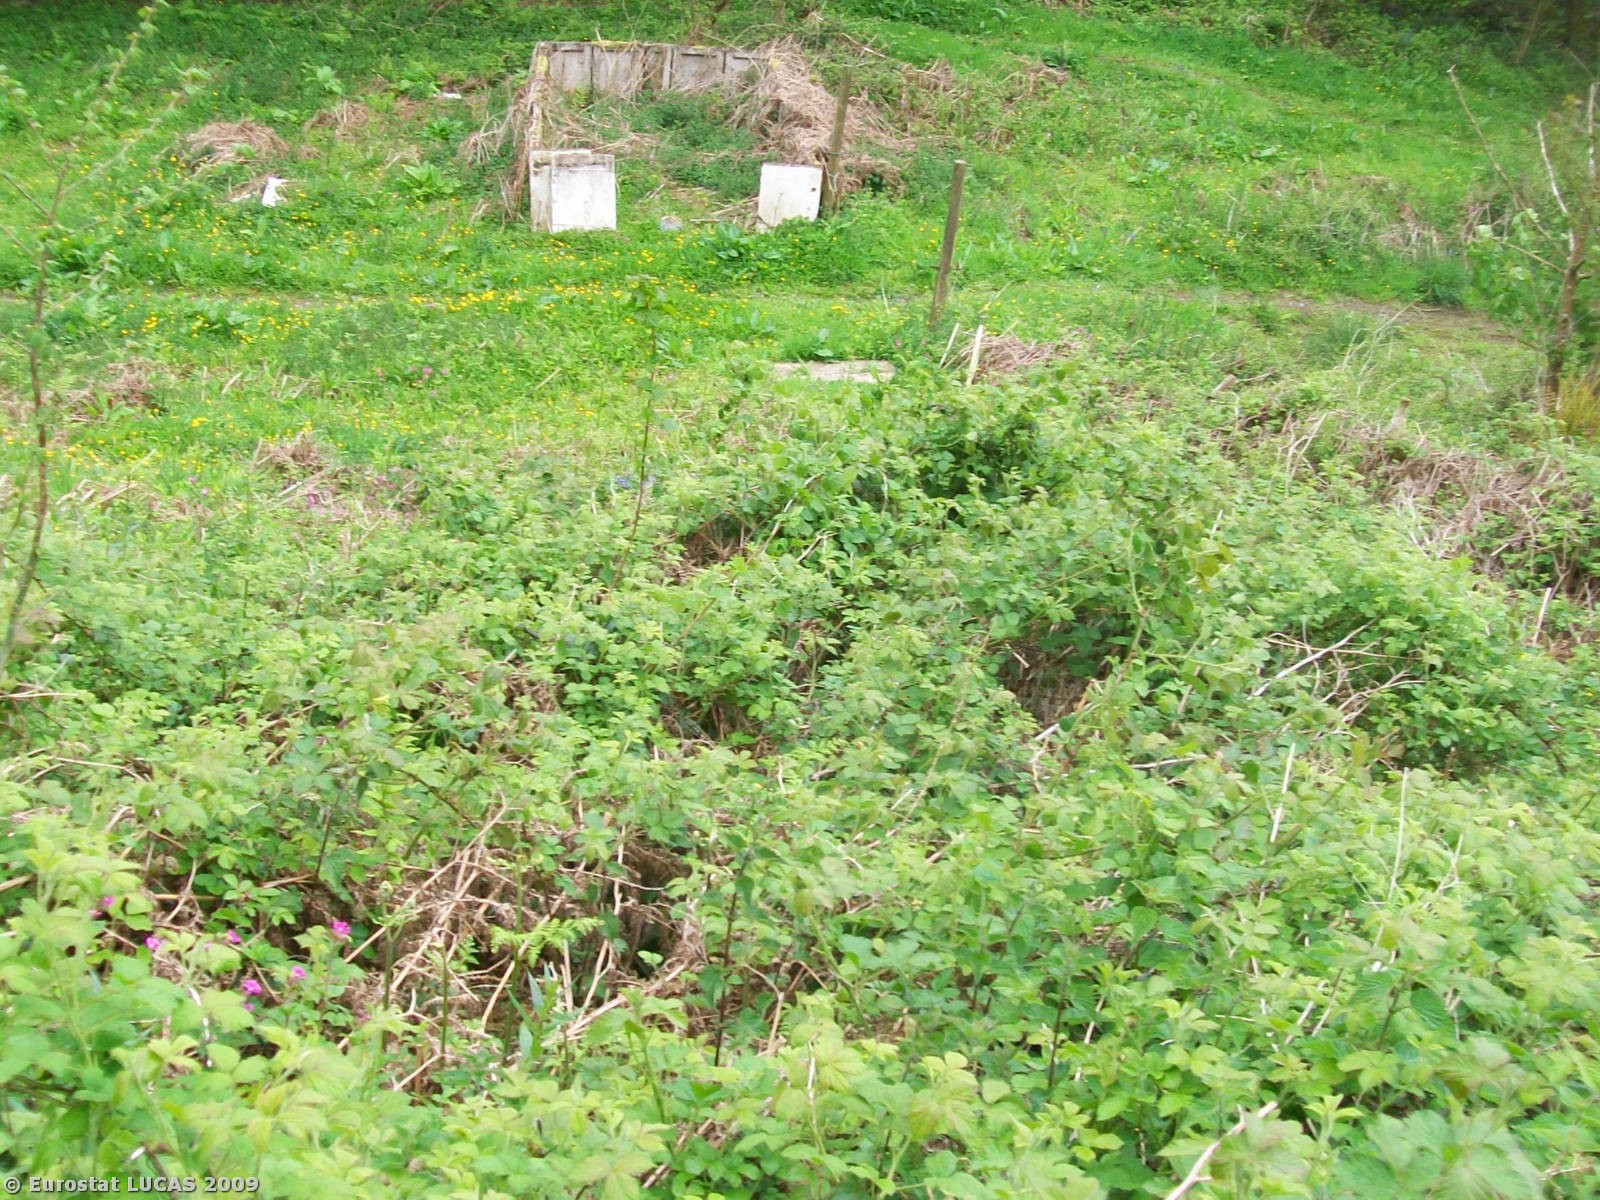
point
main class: Shrubland
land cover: Shrubland with sparse tree cover
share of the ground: > 75 %
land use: Agriculture (excluding fallow land and kitchen gardens)
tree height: > 5 m
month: May
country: GB
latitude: 50.5046
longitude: -4.2695
